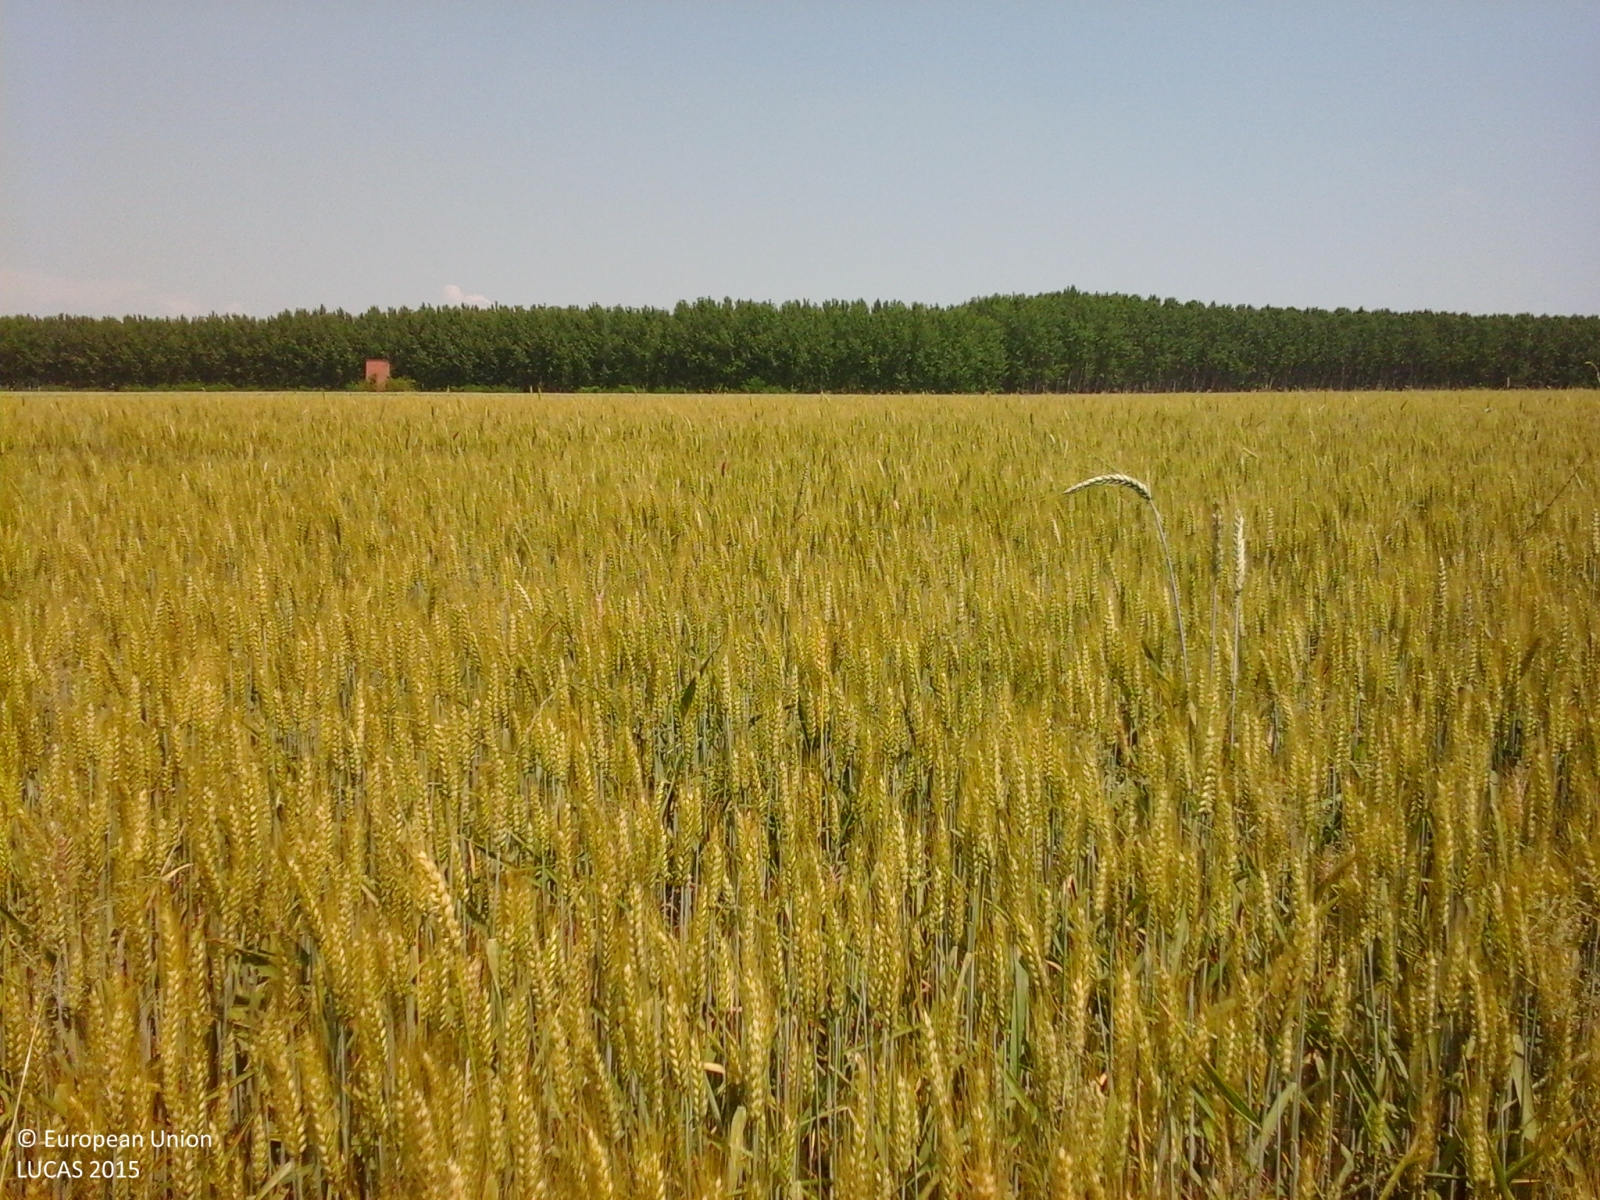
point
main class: Cropland
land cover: Common wheat
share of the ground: > 75 %
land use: Agriculture (excluding fallow land and kitchen gardens)
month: June
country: IT
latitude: 44.9042
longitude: 7.7878
